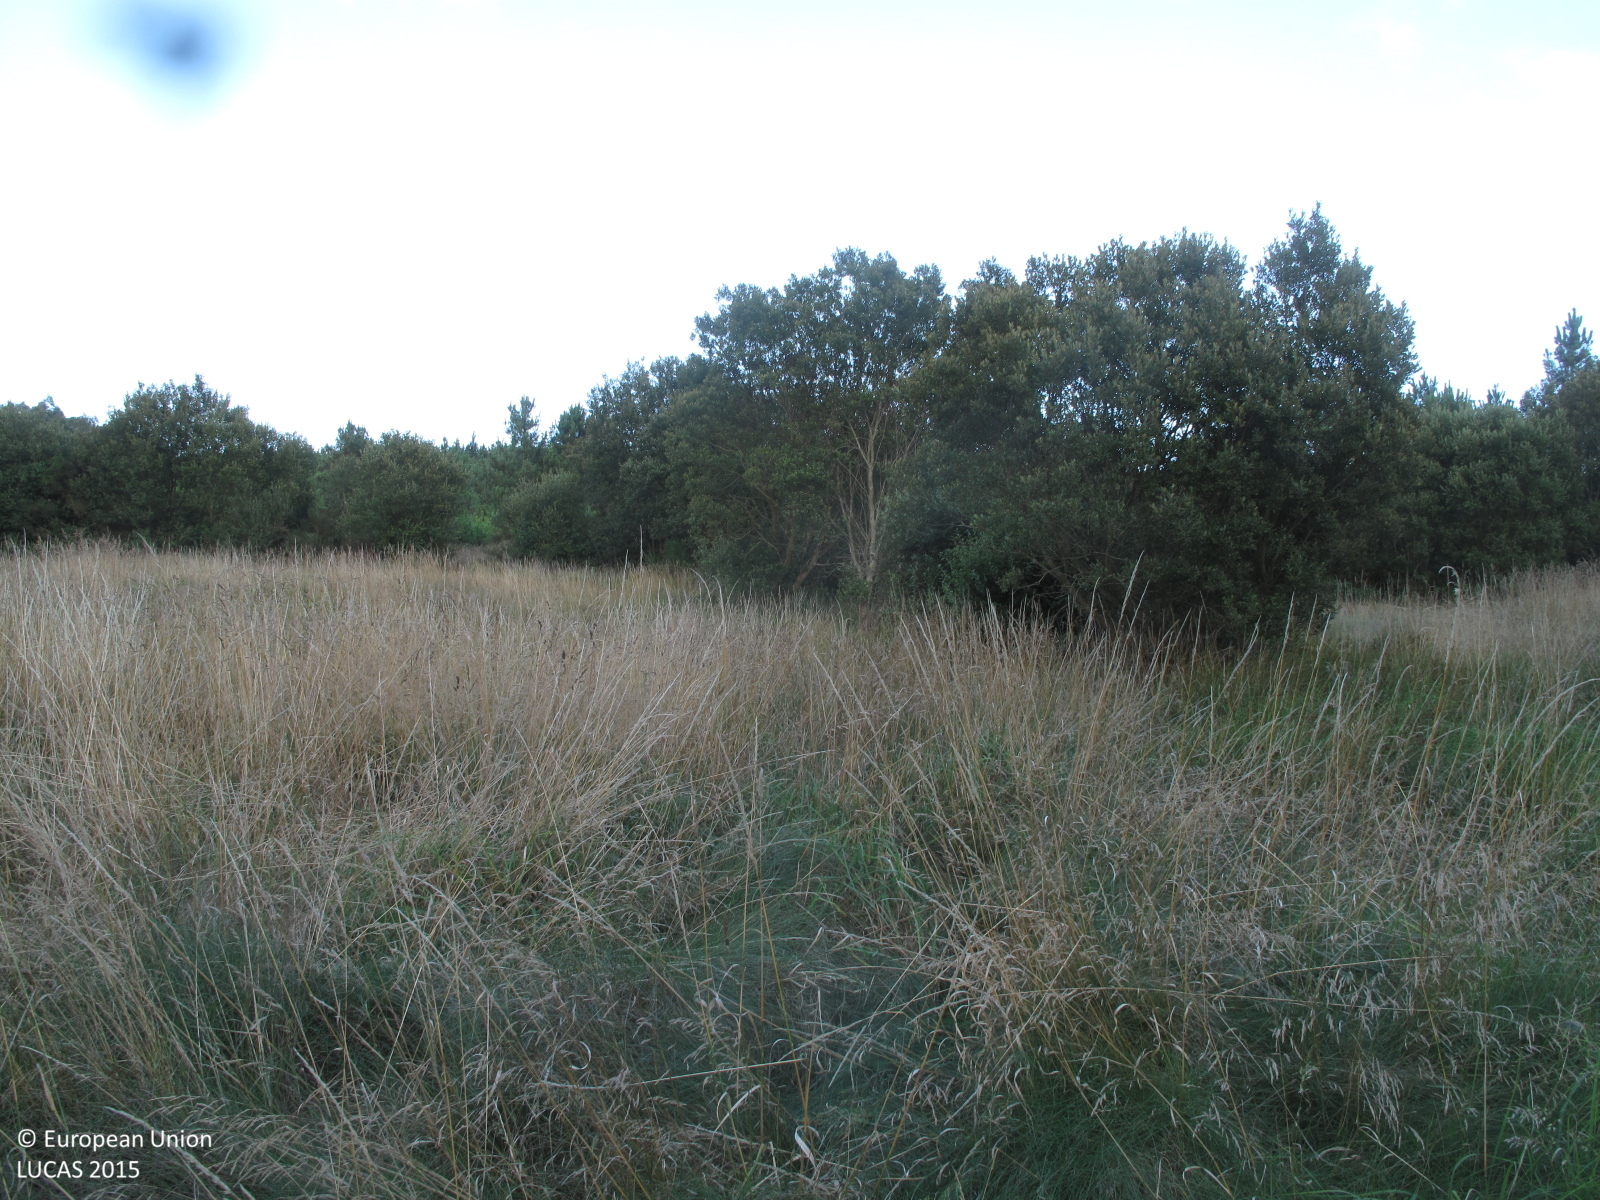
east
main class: Woodland
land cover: Pine dominated mixed woodland
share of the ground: 10 - 25 %
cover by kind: herbaceous plants 60 %, shrubs 20 %, coniferous forest trees 15 %, broadleaved forest trees 5 %
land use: Semi-natural and natural areas not in use
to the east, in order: Pine dominated mixed woodland; Tracks; Pine dominated coniferous woodland; Shrubland with sparse tree cover; Rock outcrops; Shrubland with sparse tree cover
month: July
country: ES
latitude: 42.8952
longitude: -9.0664
